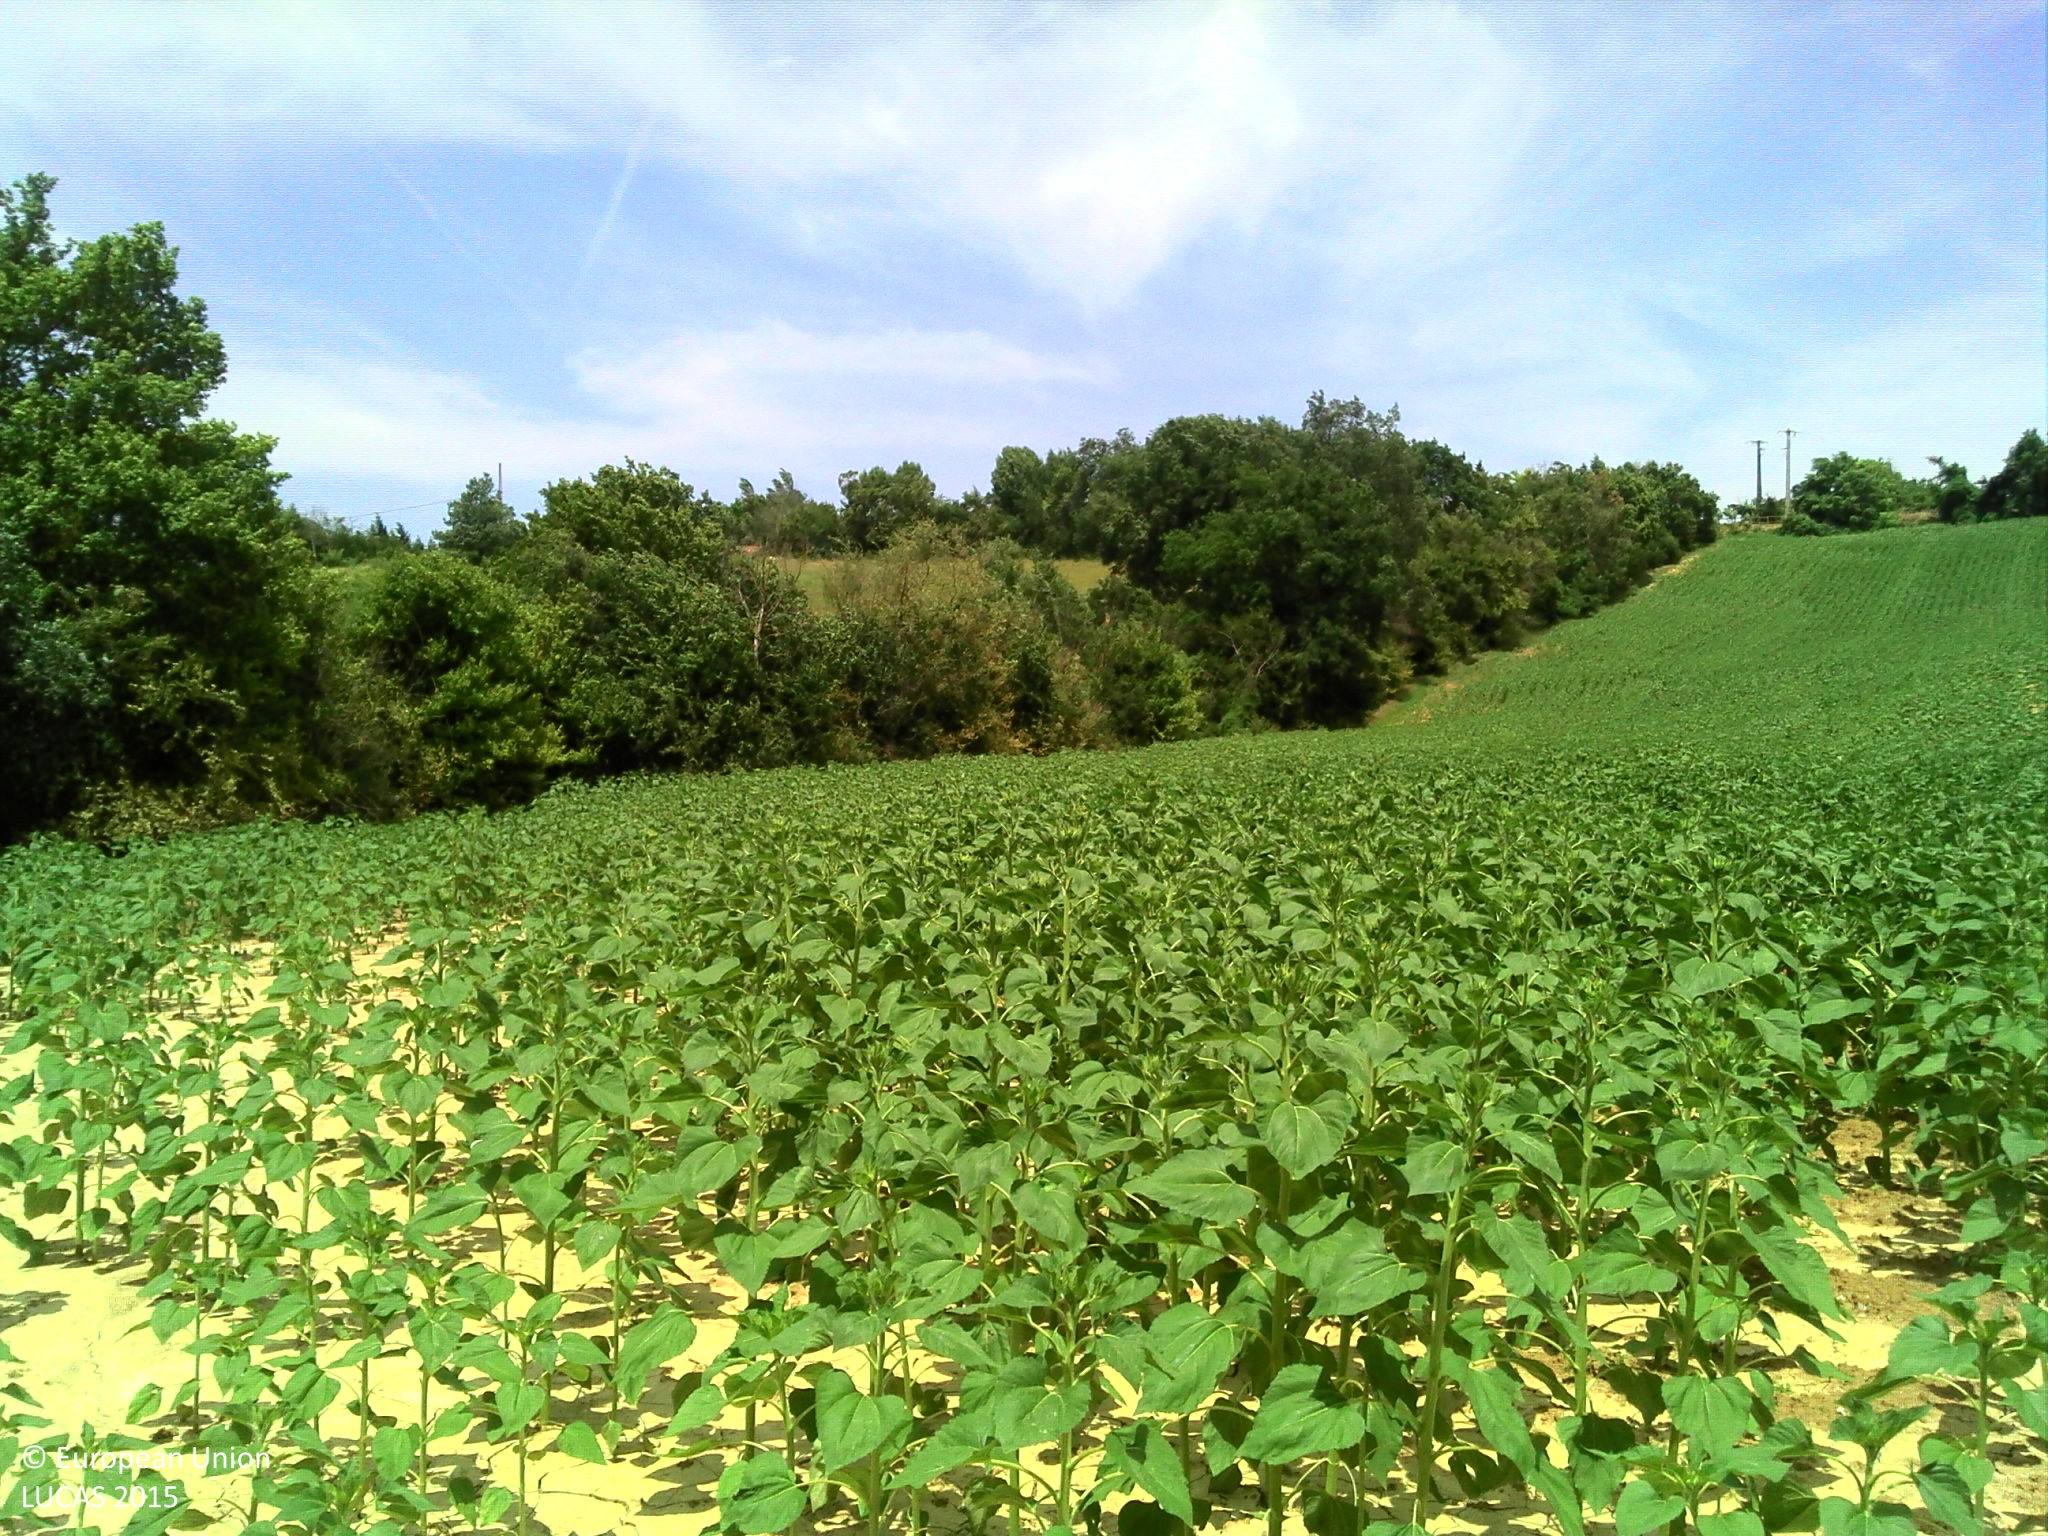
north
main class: Cropland
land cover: Sunflower
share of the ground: > 75 %
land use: Agriculture (excluding fallow land and kitchen gardens)
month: July
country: FR
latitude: 43.5282
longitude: 1.0552
